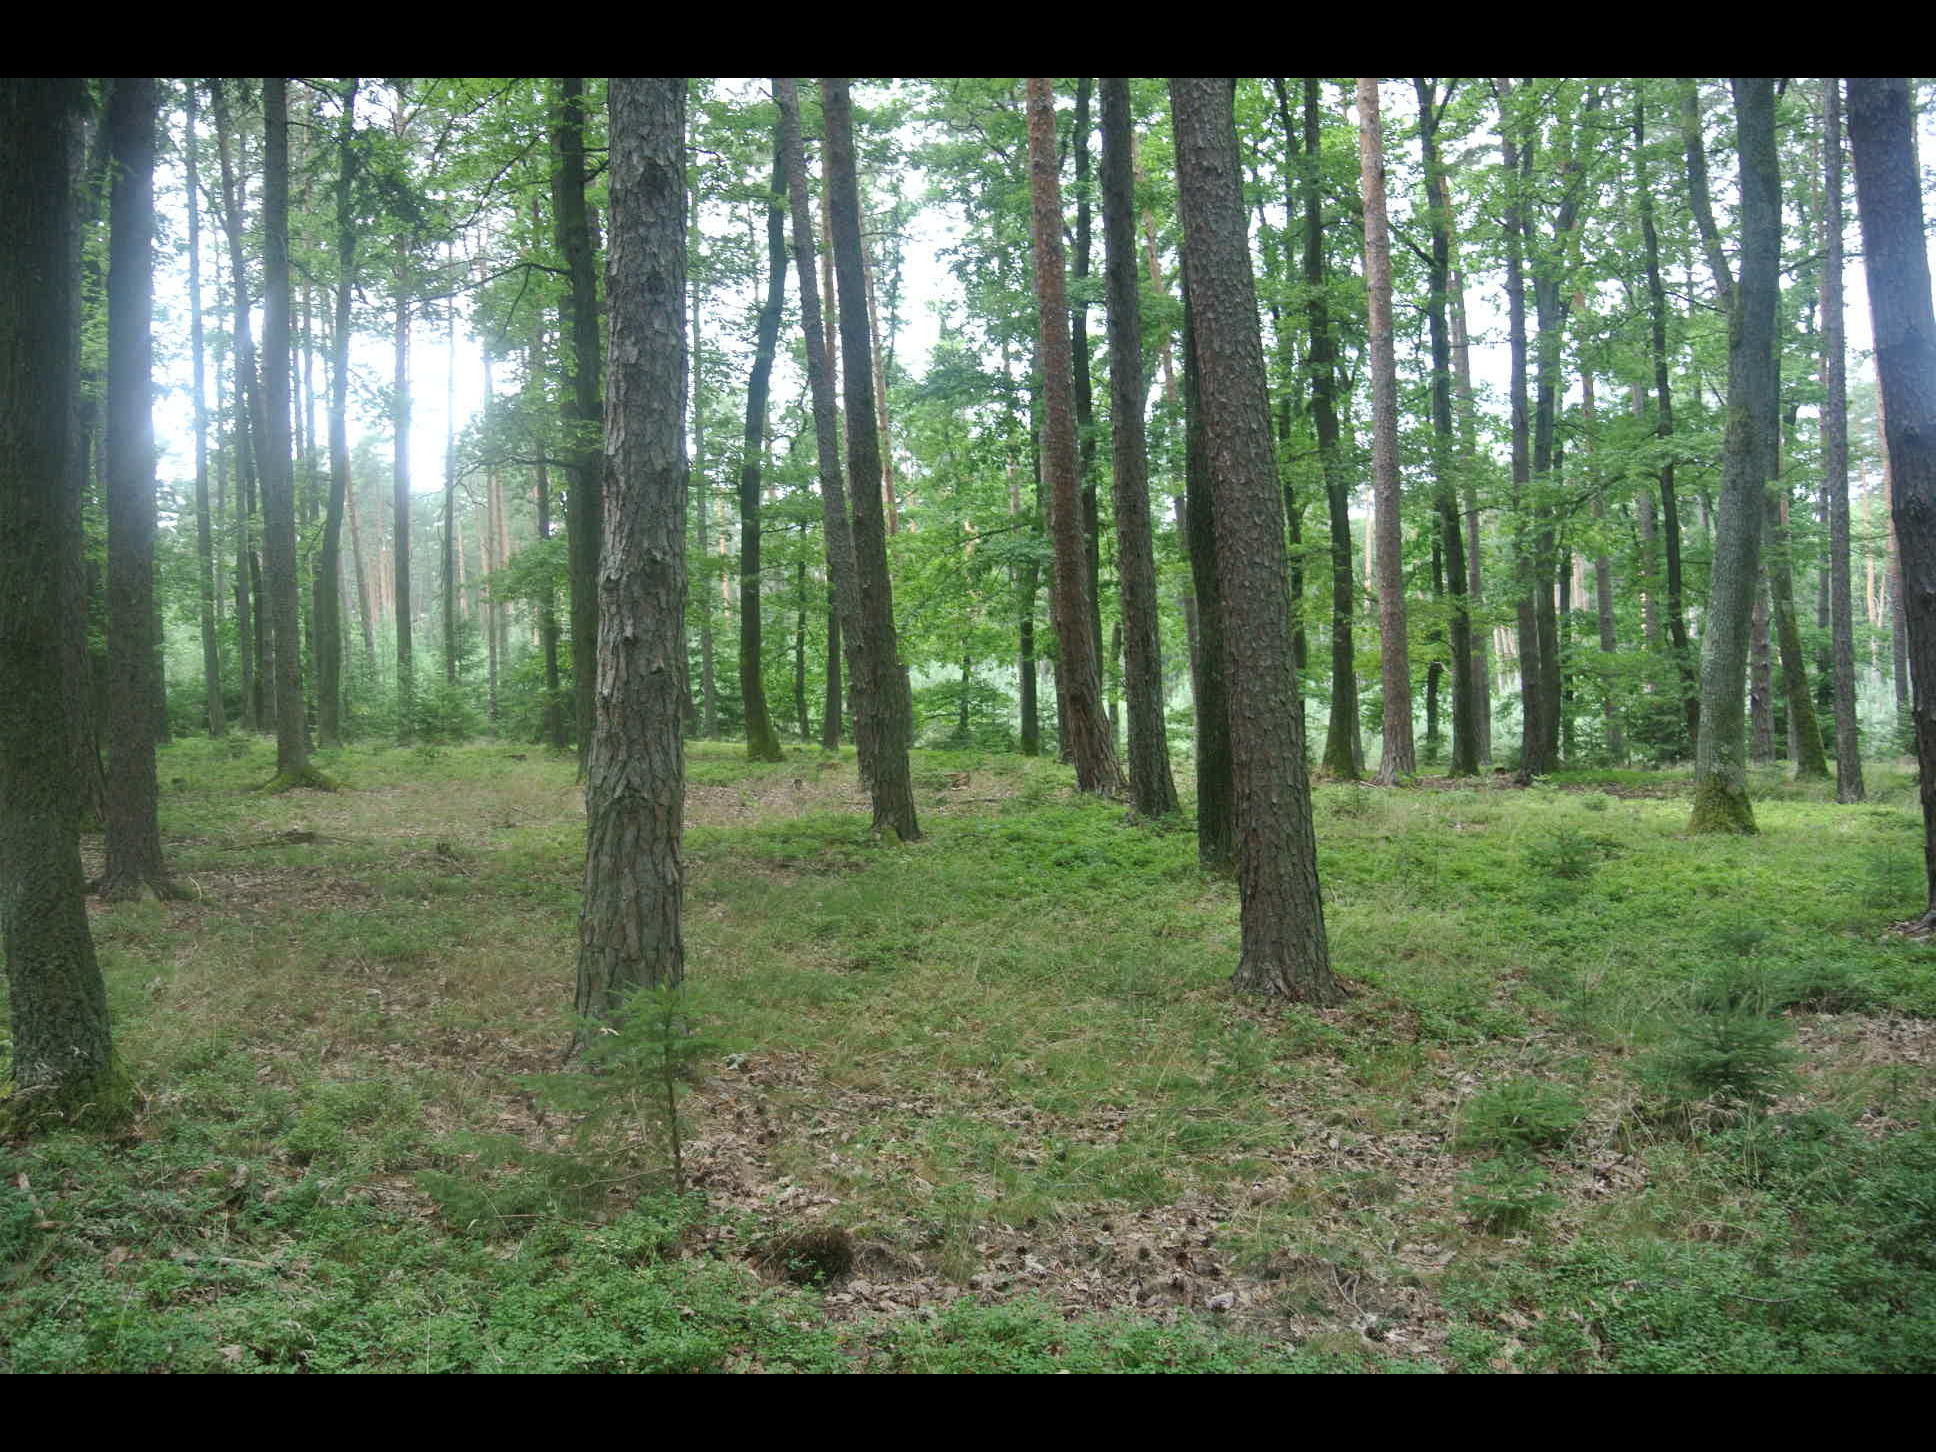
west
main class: Woodland
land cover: Pine dominated mixed woodland
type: alpine coniferous forest
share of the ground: > 75 %
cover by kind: coniferous forest trees 55 %, broadleaved forest trees 45 %
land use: Forestry
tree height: > 5 m
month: July
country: AT
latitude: 47.4756
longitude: 16.4390
